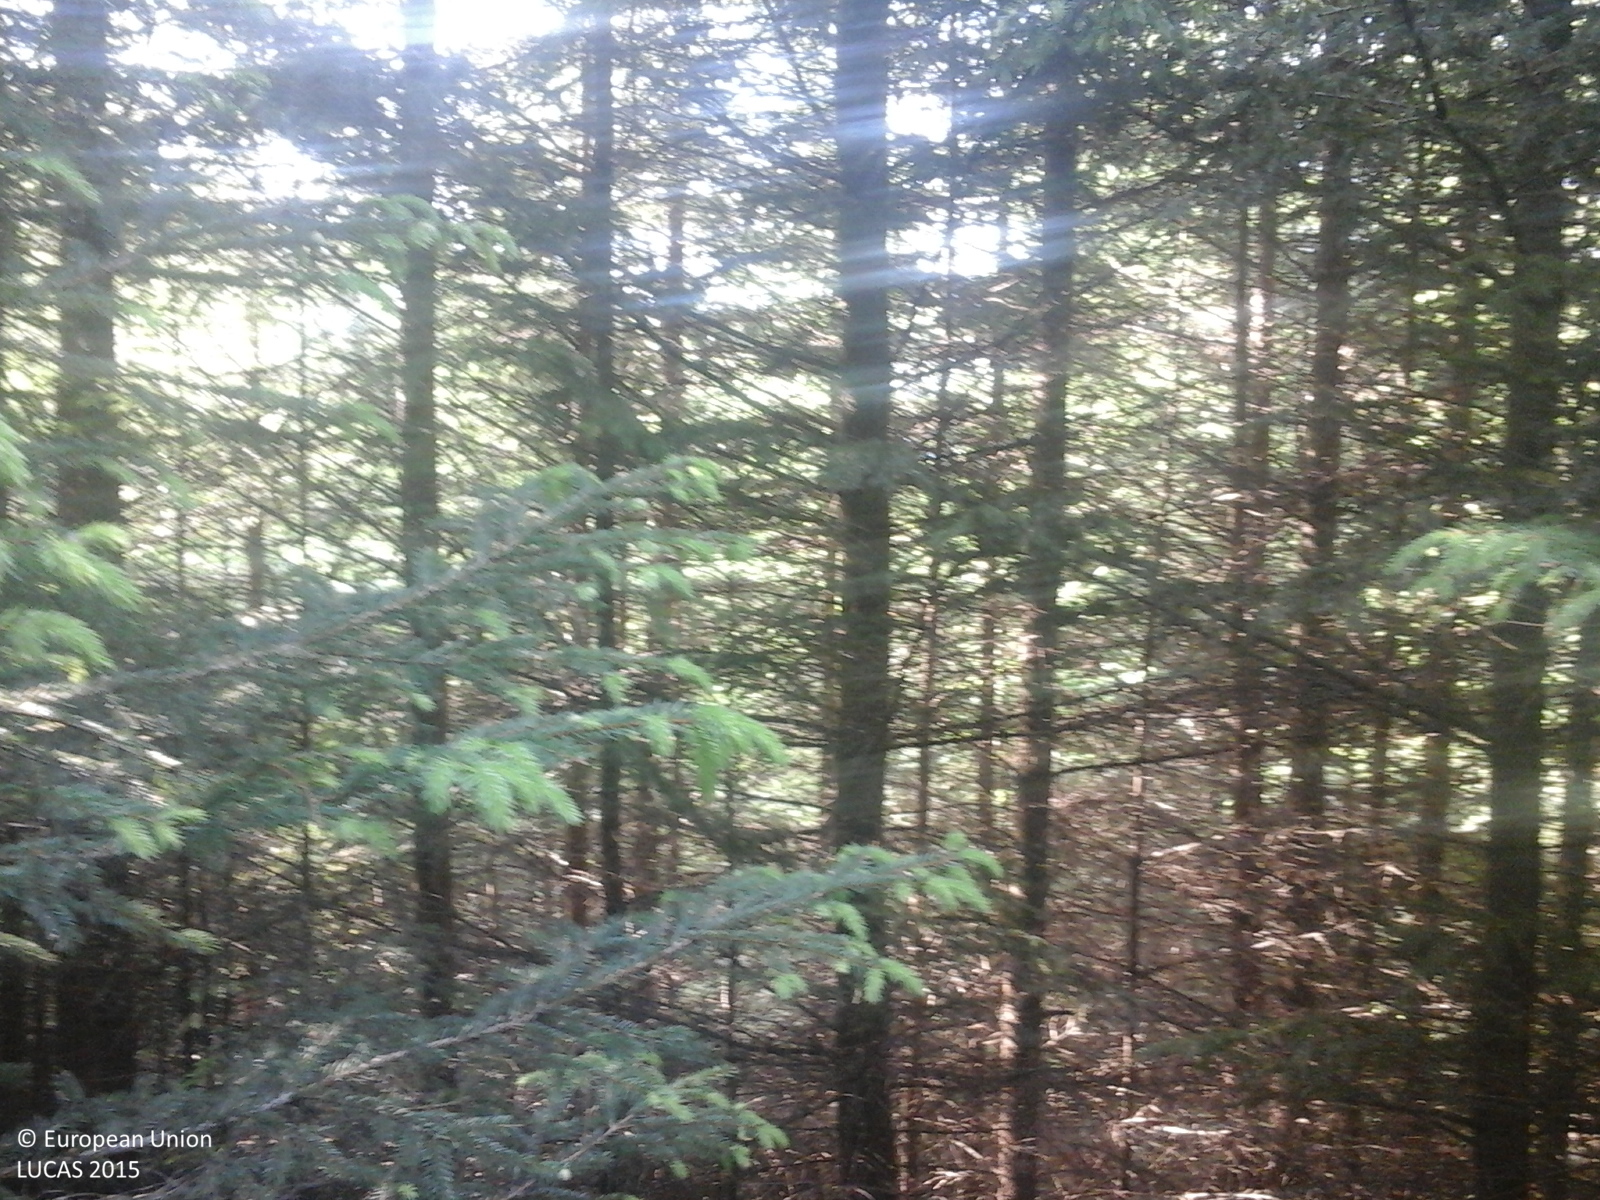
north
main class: Woodland
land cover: Spruce dominated coniferous woodland
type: alpine coniferous forest
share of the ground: > 75 %
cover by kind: coniferous forest trees 100 %
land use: Forestry
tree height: > 5 m
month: June
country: RO
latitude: 47.6014
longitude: 25.8333
